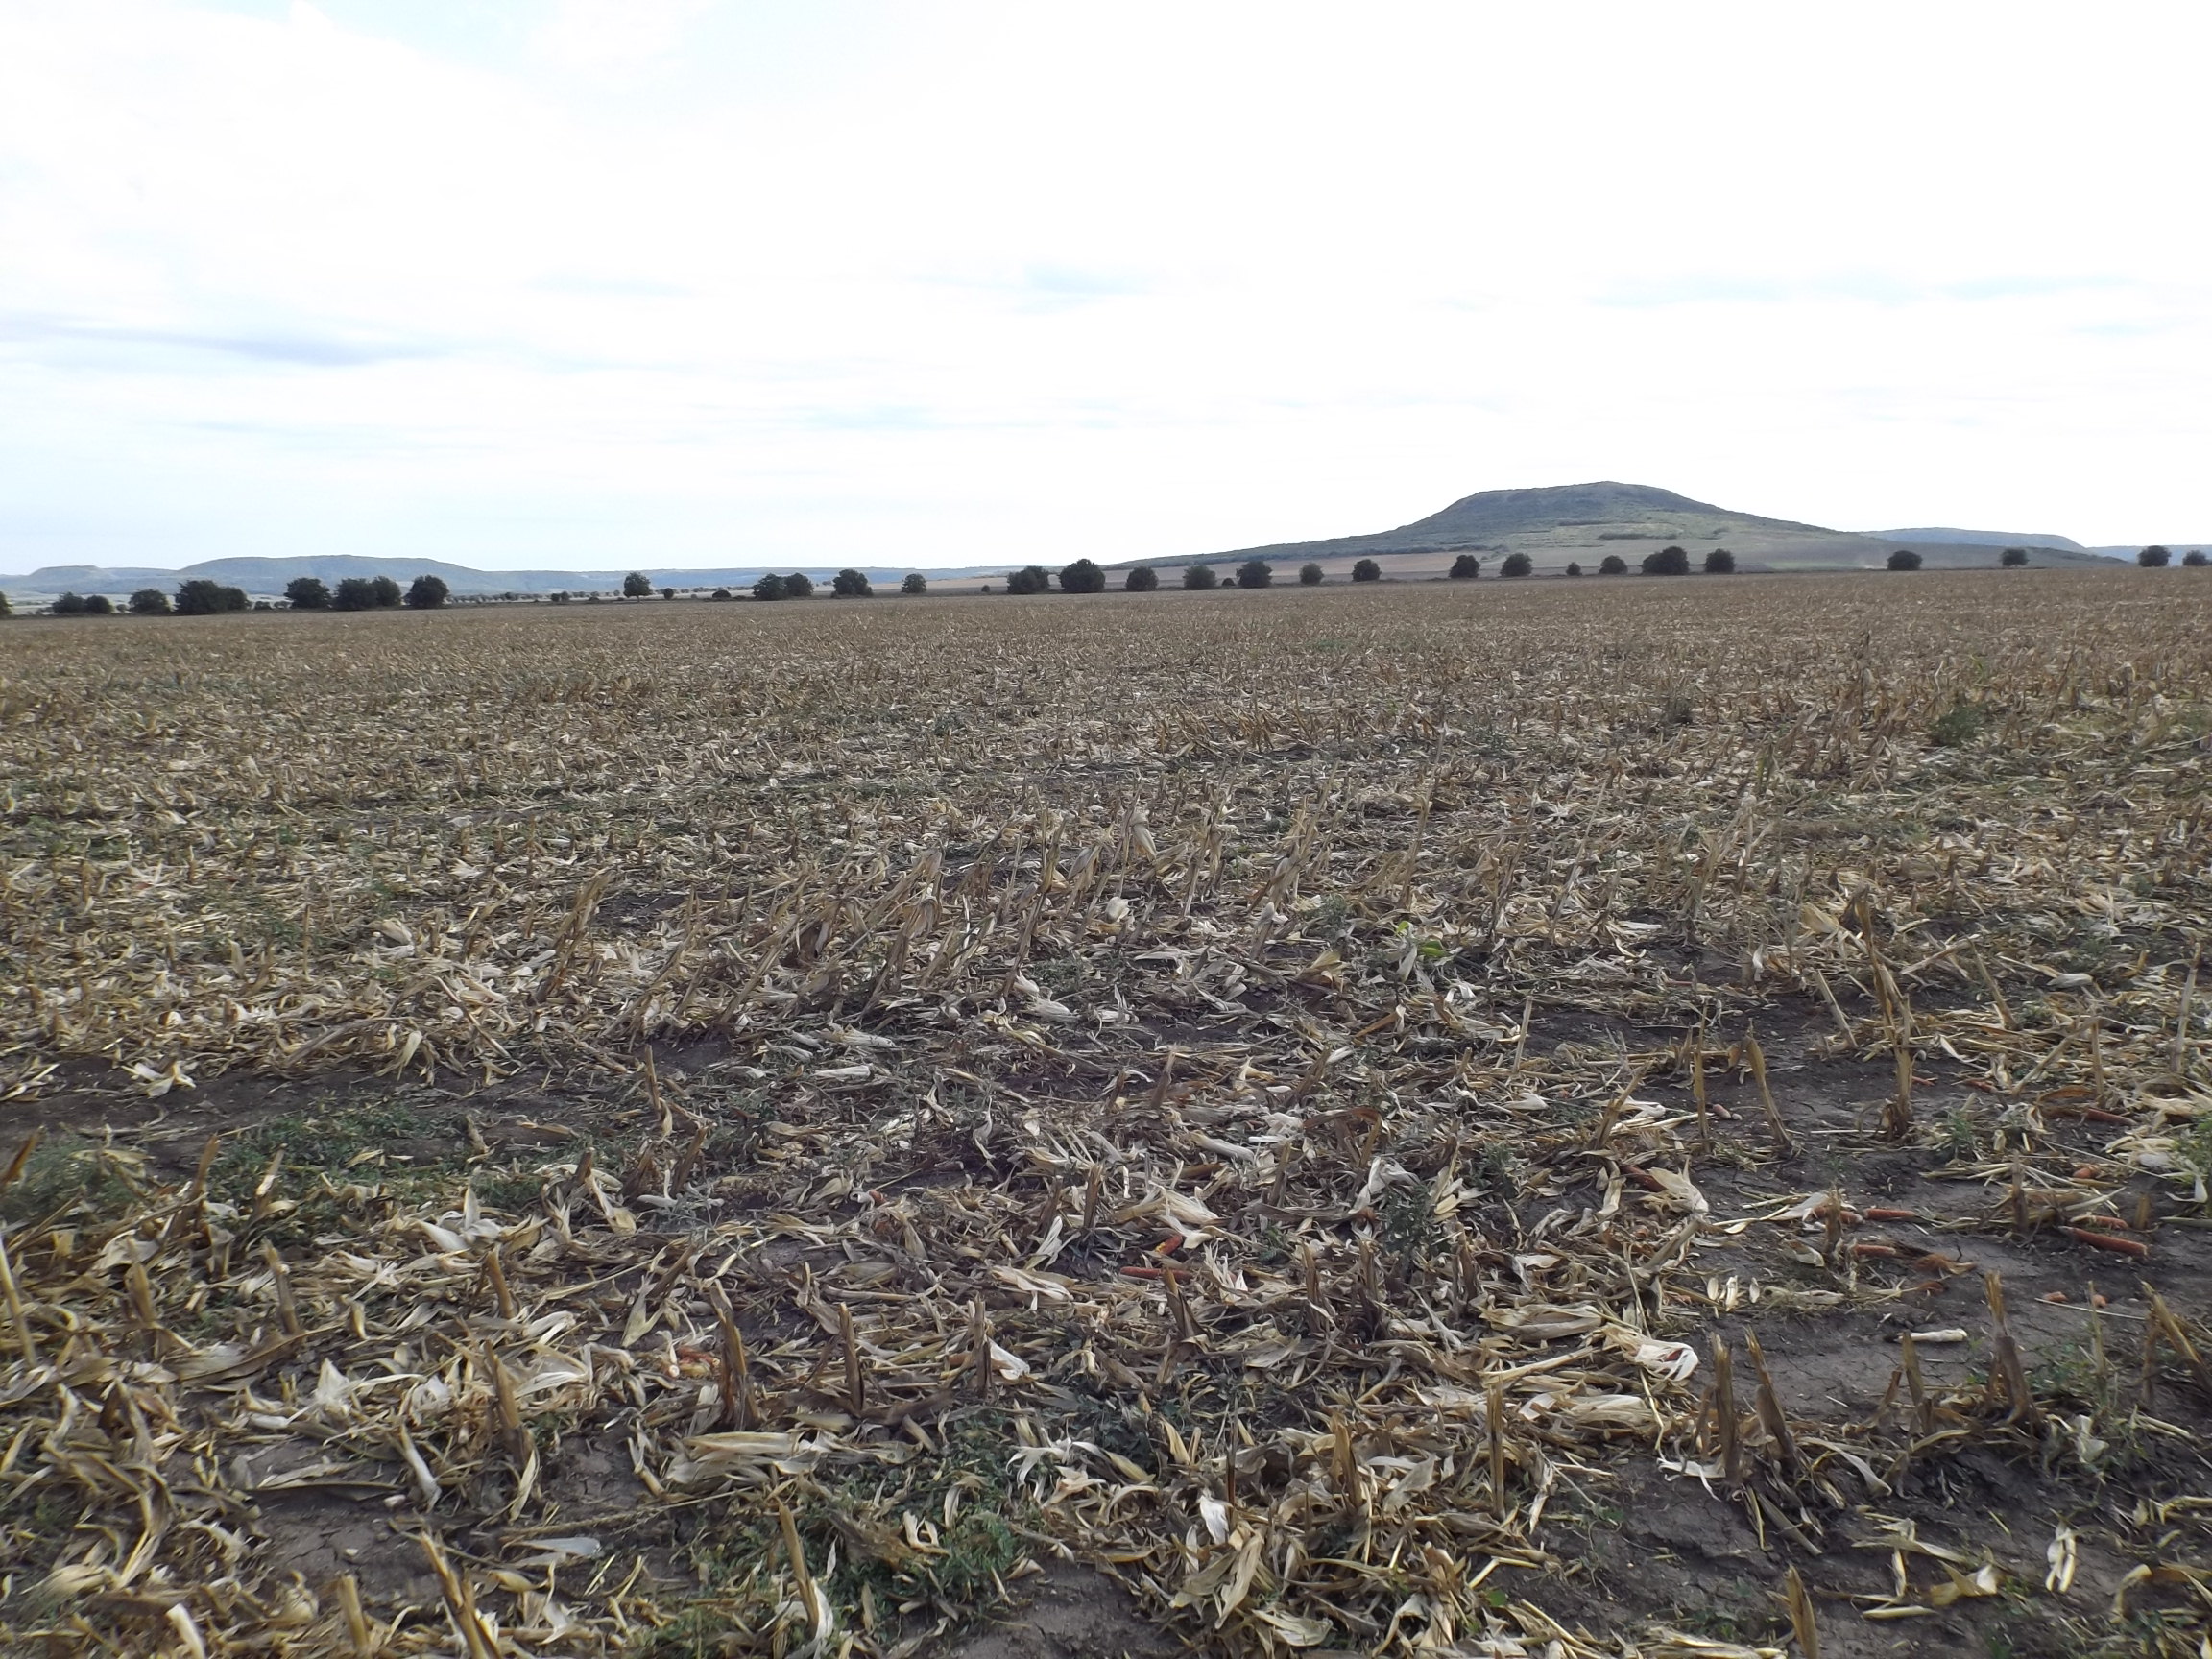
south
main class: Cropland
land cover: Maize
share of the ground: < 10 %
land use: Agriculture (excluding fallow land and kitchen gardens)
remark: Harvested field
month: September
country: BG
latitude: 43.3214
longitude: 27.3260
